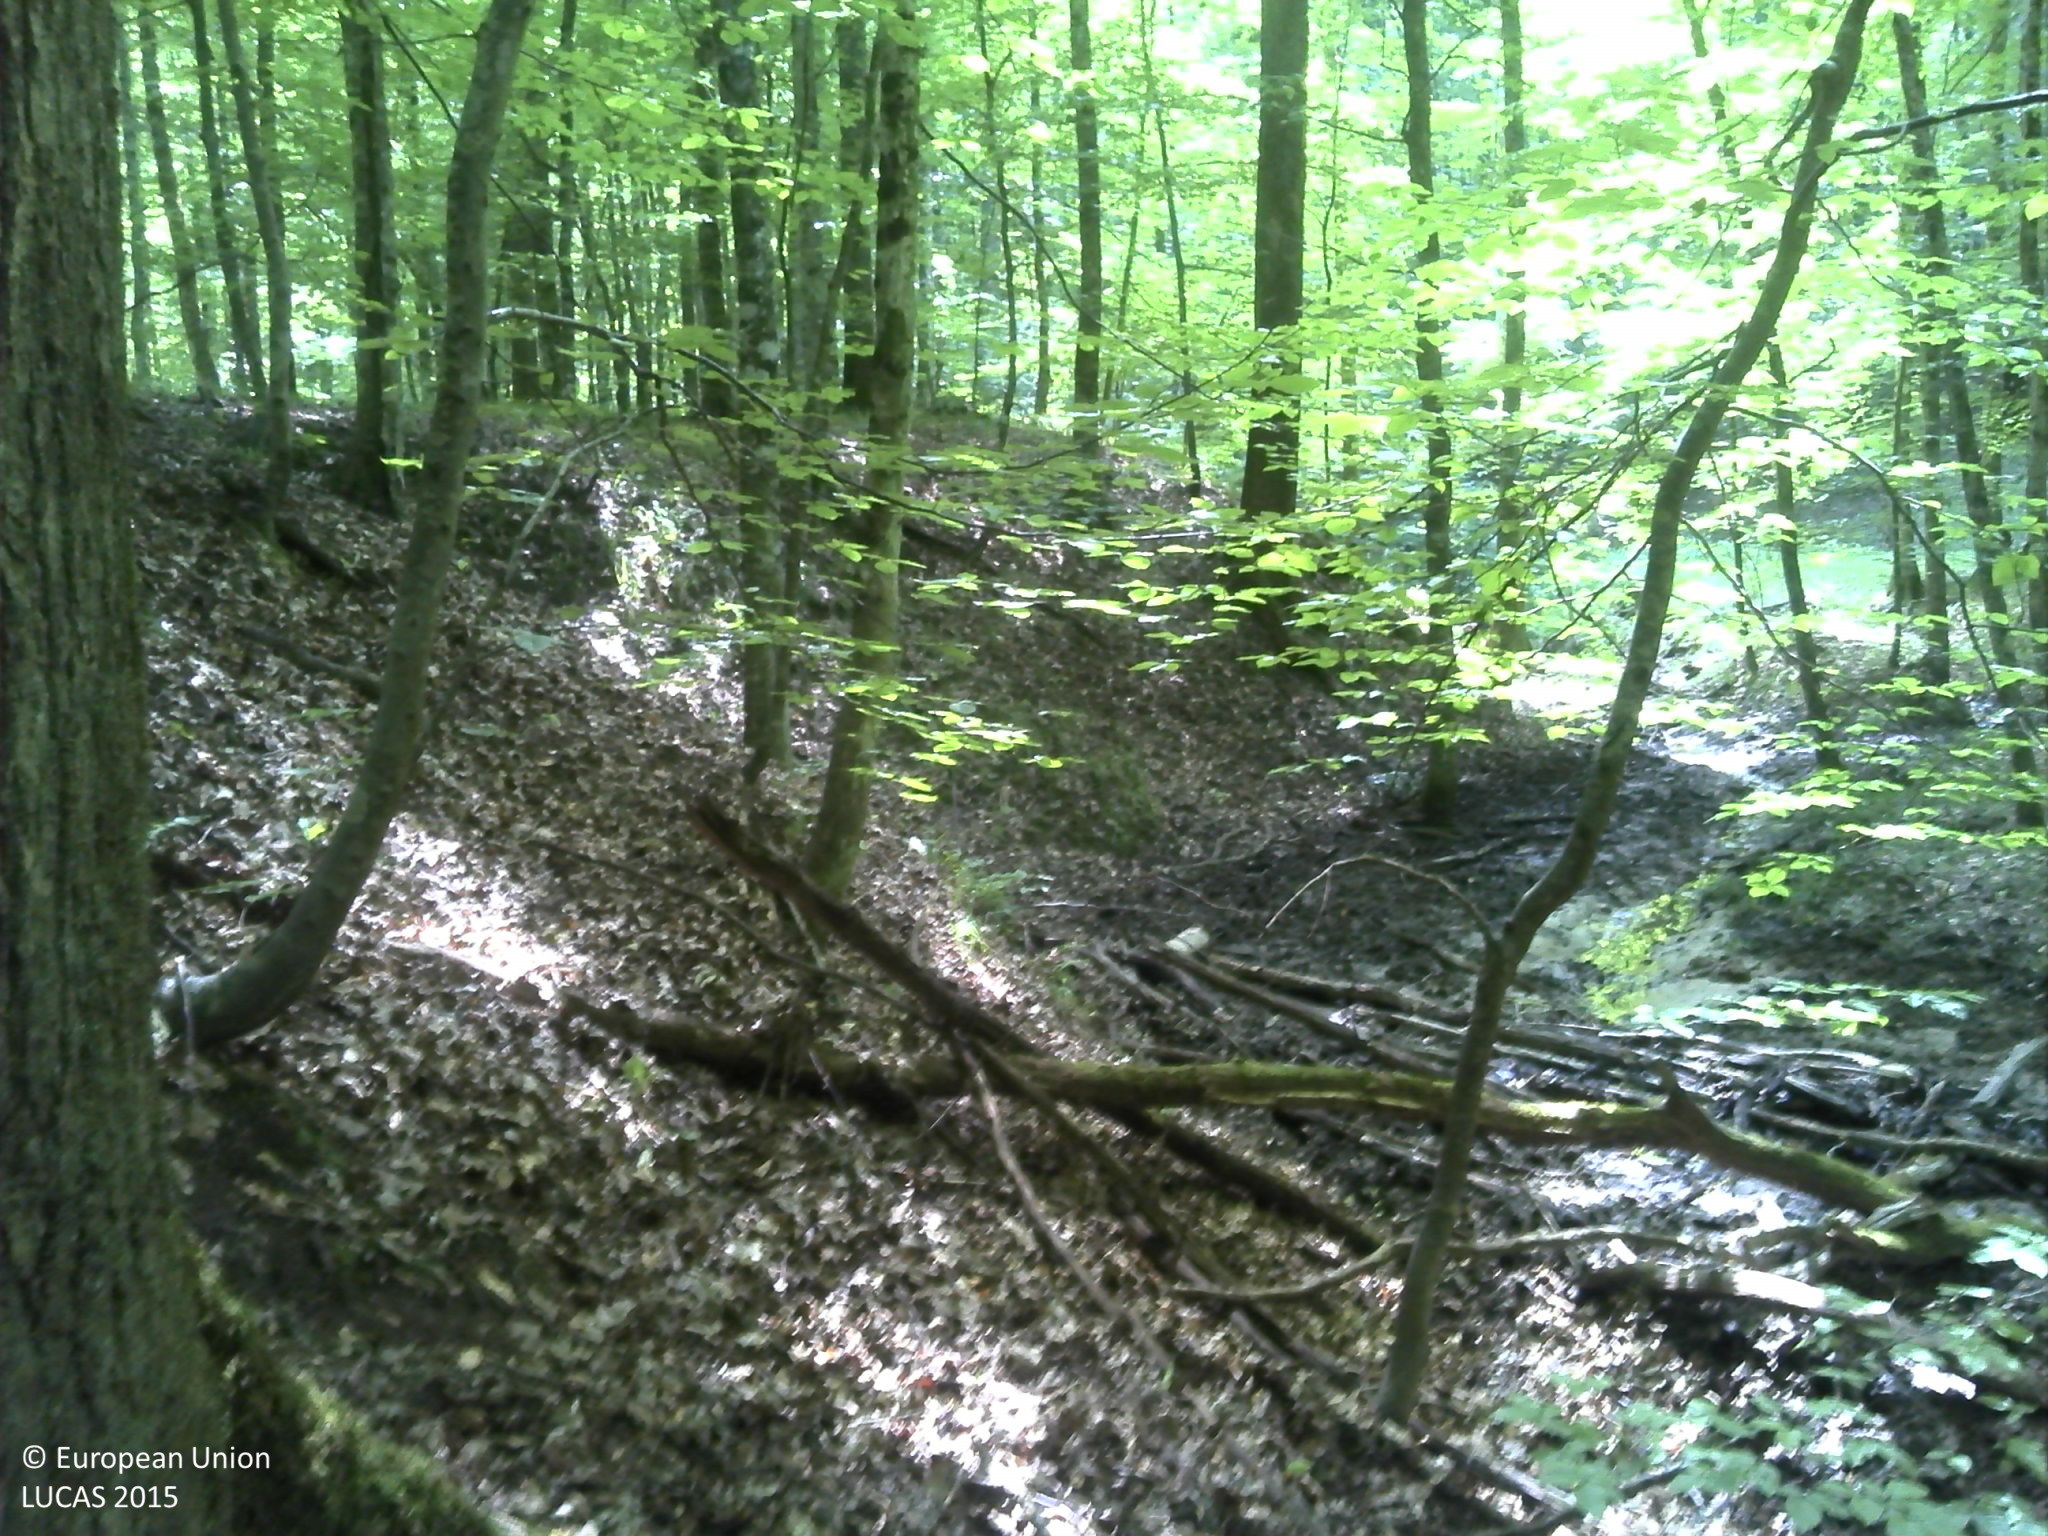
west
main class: Woodland
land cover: Broadleaved woodland
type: acidophilous oak and oak-birch forest
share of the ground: > 75 %
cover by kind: broadleaved forest trees 90 %, shrubs 5 %, herbaceous plants 5 %
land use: Forestry
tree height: > 5 m
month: June
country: HR
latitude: 45.6363
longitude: 17.7387
